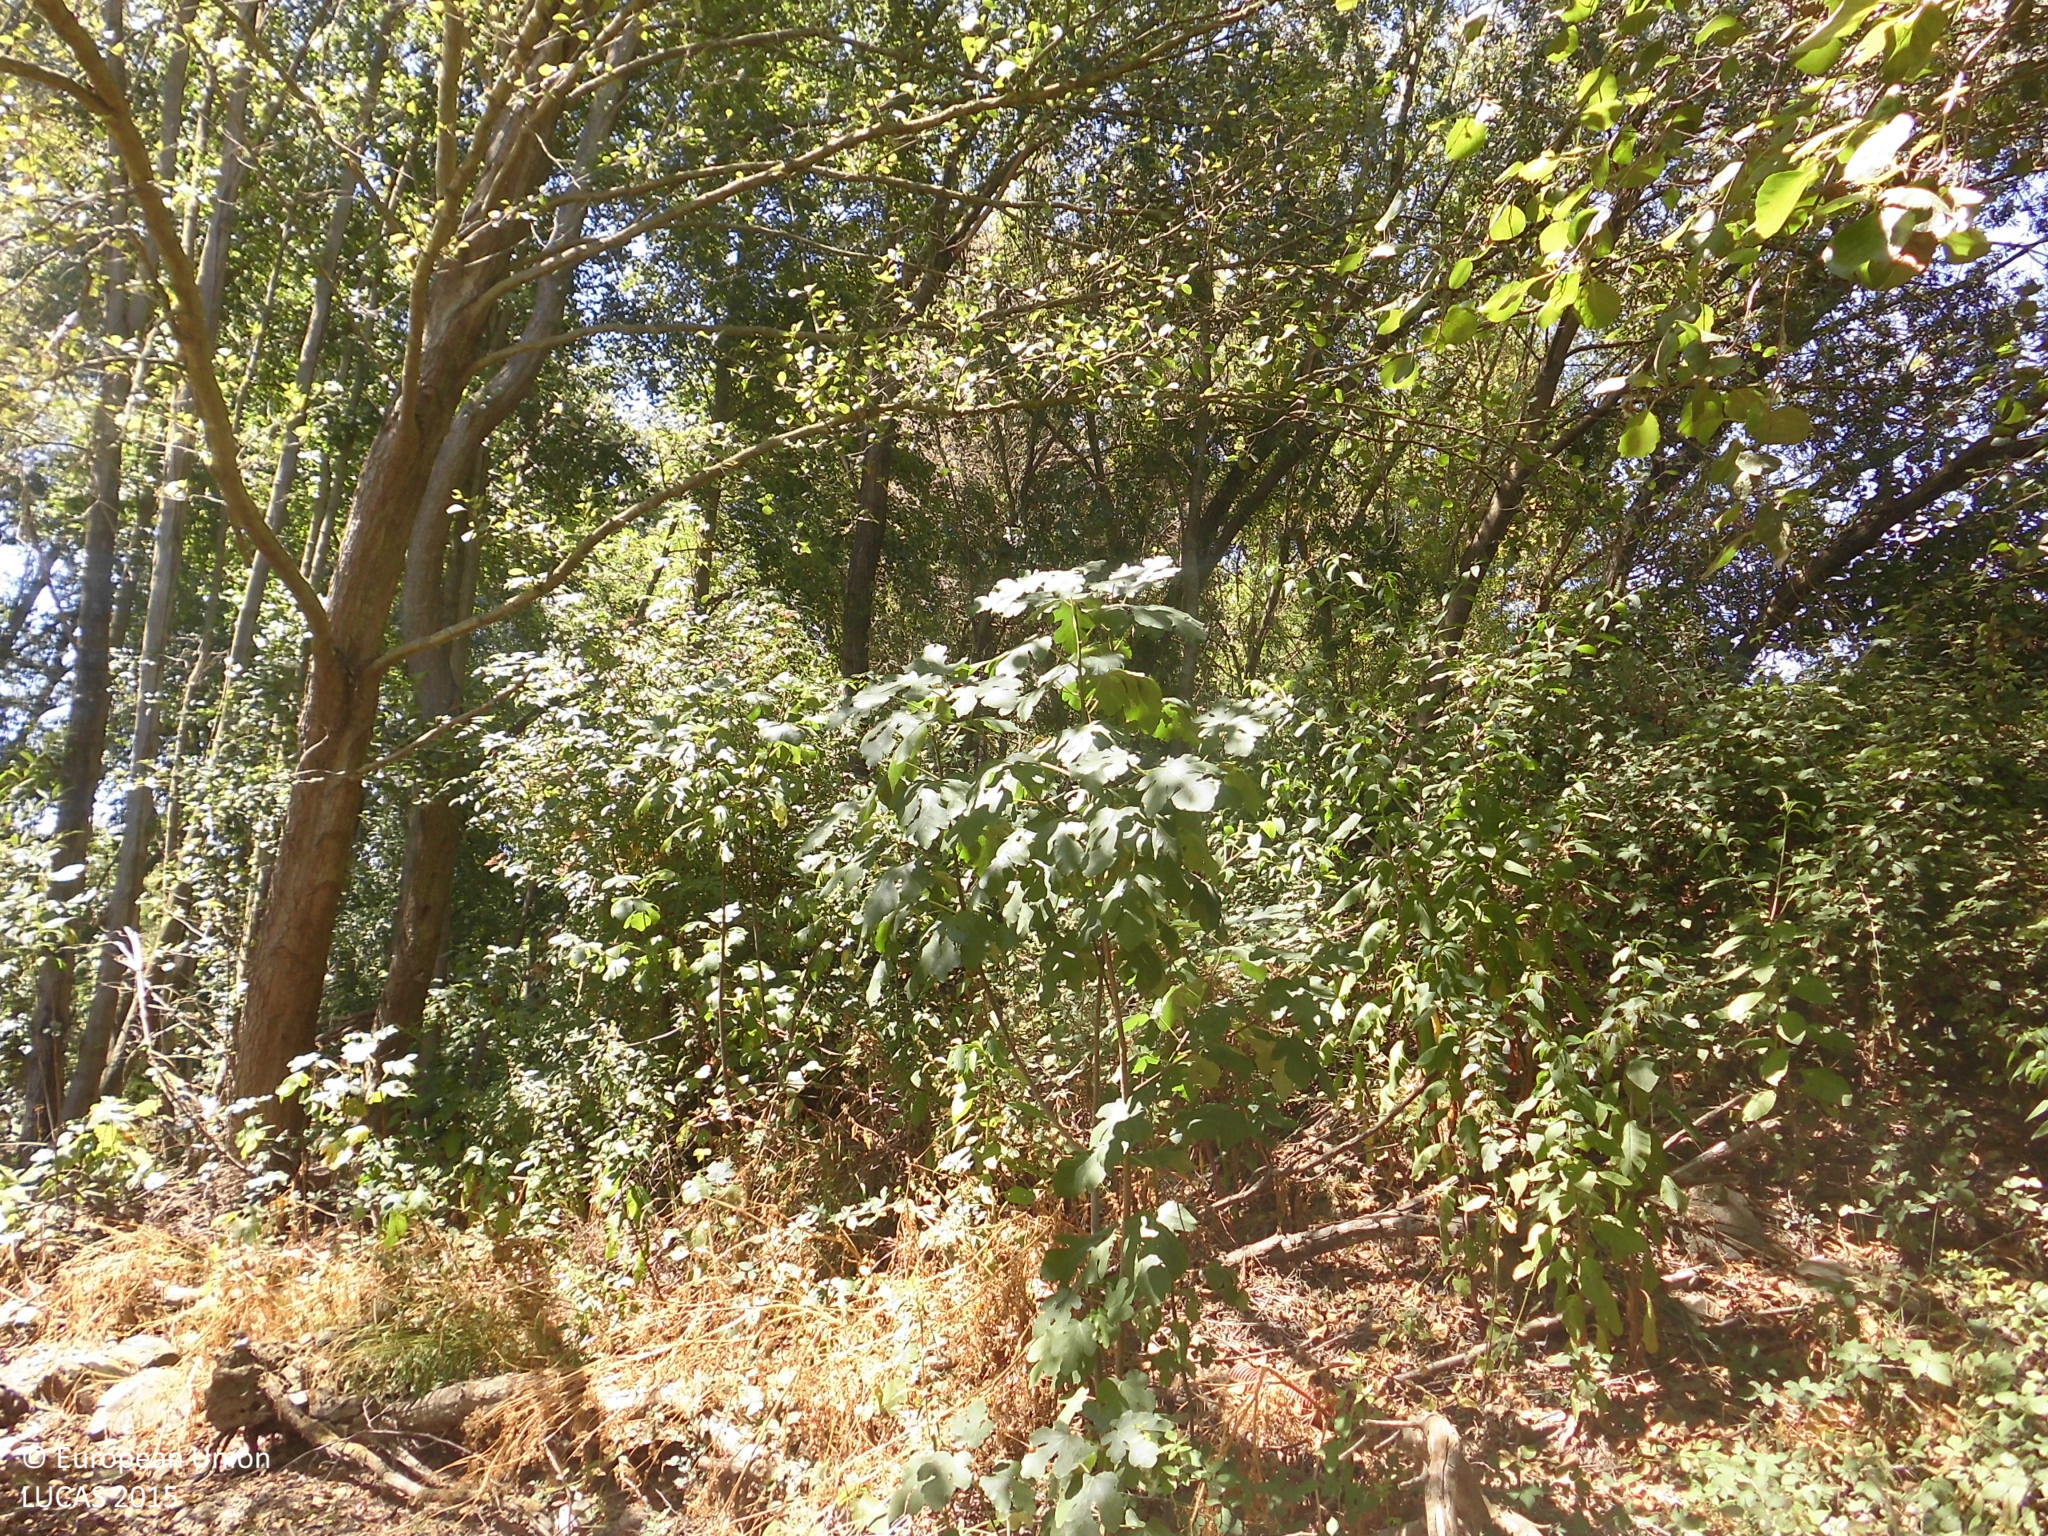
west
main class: Woodland
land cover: Broadleaved woodland
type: thermophilous deciduous forest
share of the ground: > 75 %
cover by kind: broadleaved forest trees 80 %, herbaceous plants 15 %, shrubs 5 %
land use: Semi-natural and natural areas not in use
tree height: > 5 m
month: July
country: ES
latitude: 40.0105
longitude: -6.2290
